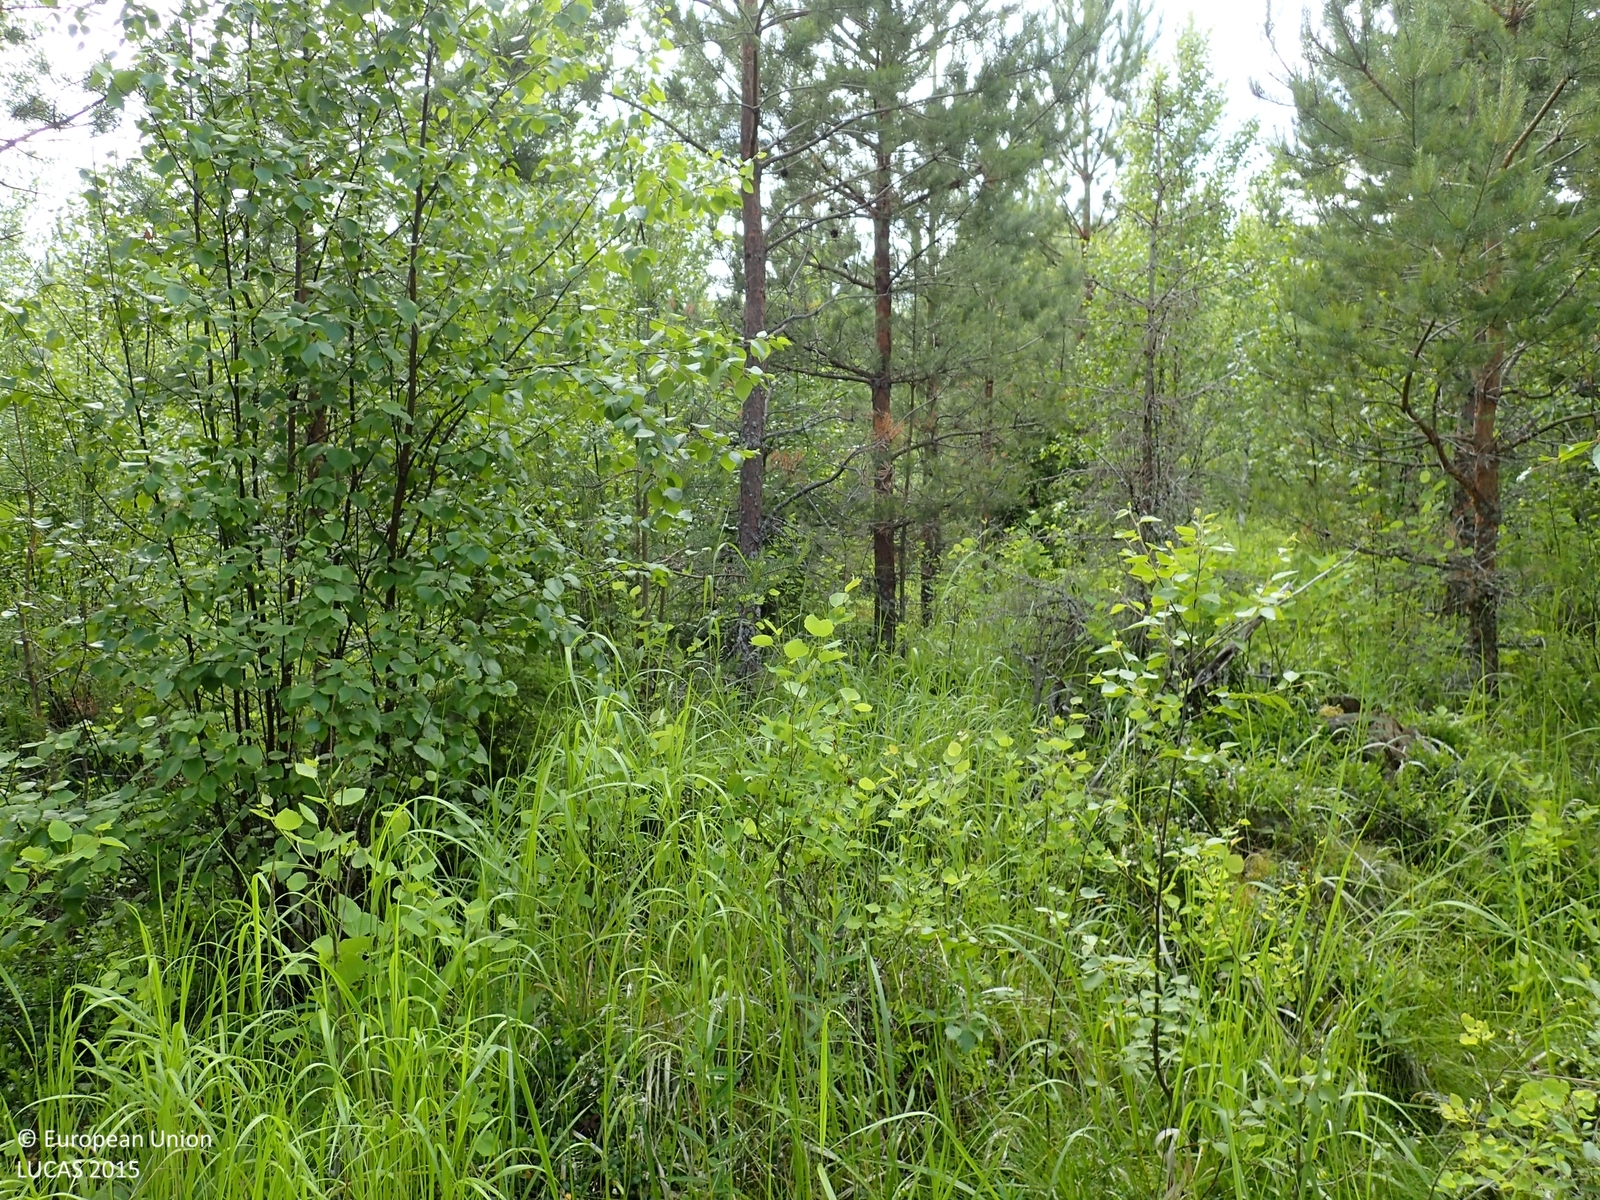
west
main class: Woodland
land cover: Pine dominated mixed woodland
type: boreal forest
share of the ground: 50 - 75 %
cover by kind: broadleaved forest trees 45 %, herbaceous plants 30 %, coniferous forest trees 15 %, shrubs 10 %
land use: Forestry
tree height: < 5 m
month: July
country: FI
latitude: 62.8080
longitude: 21.7540
